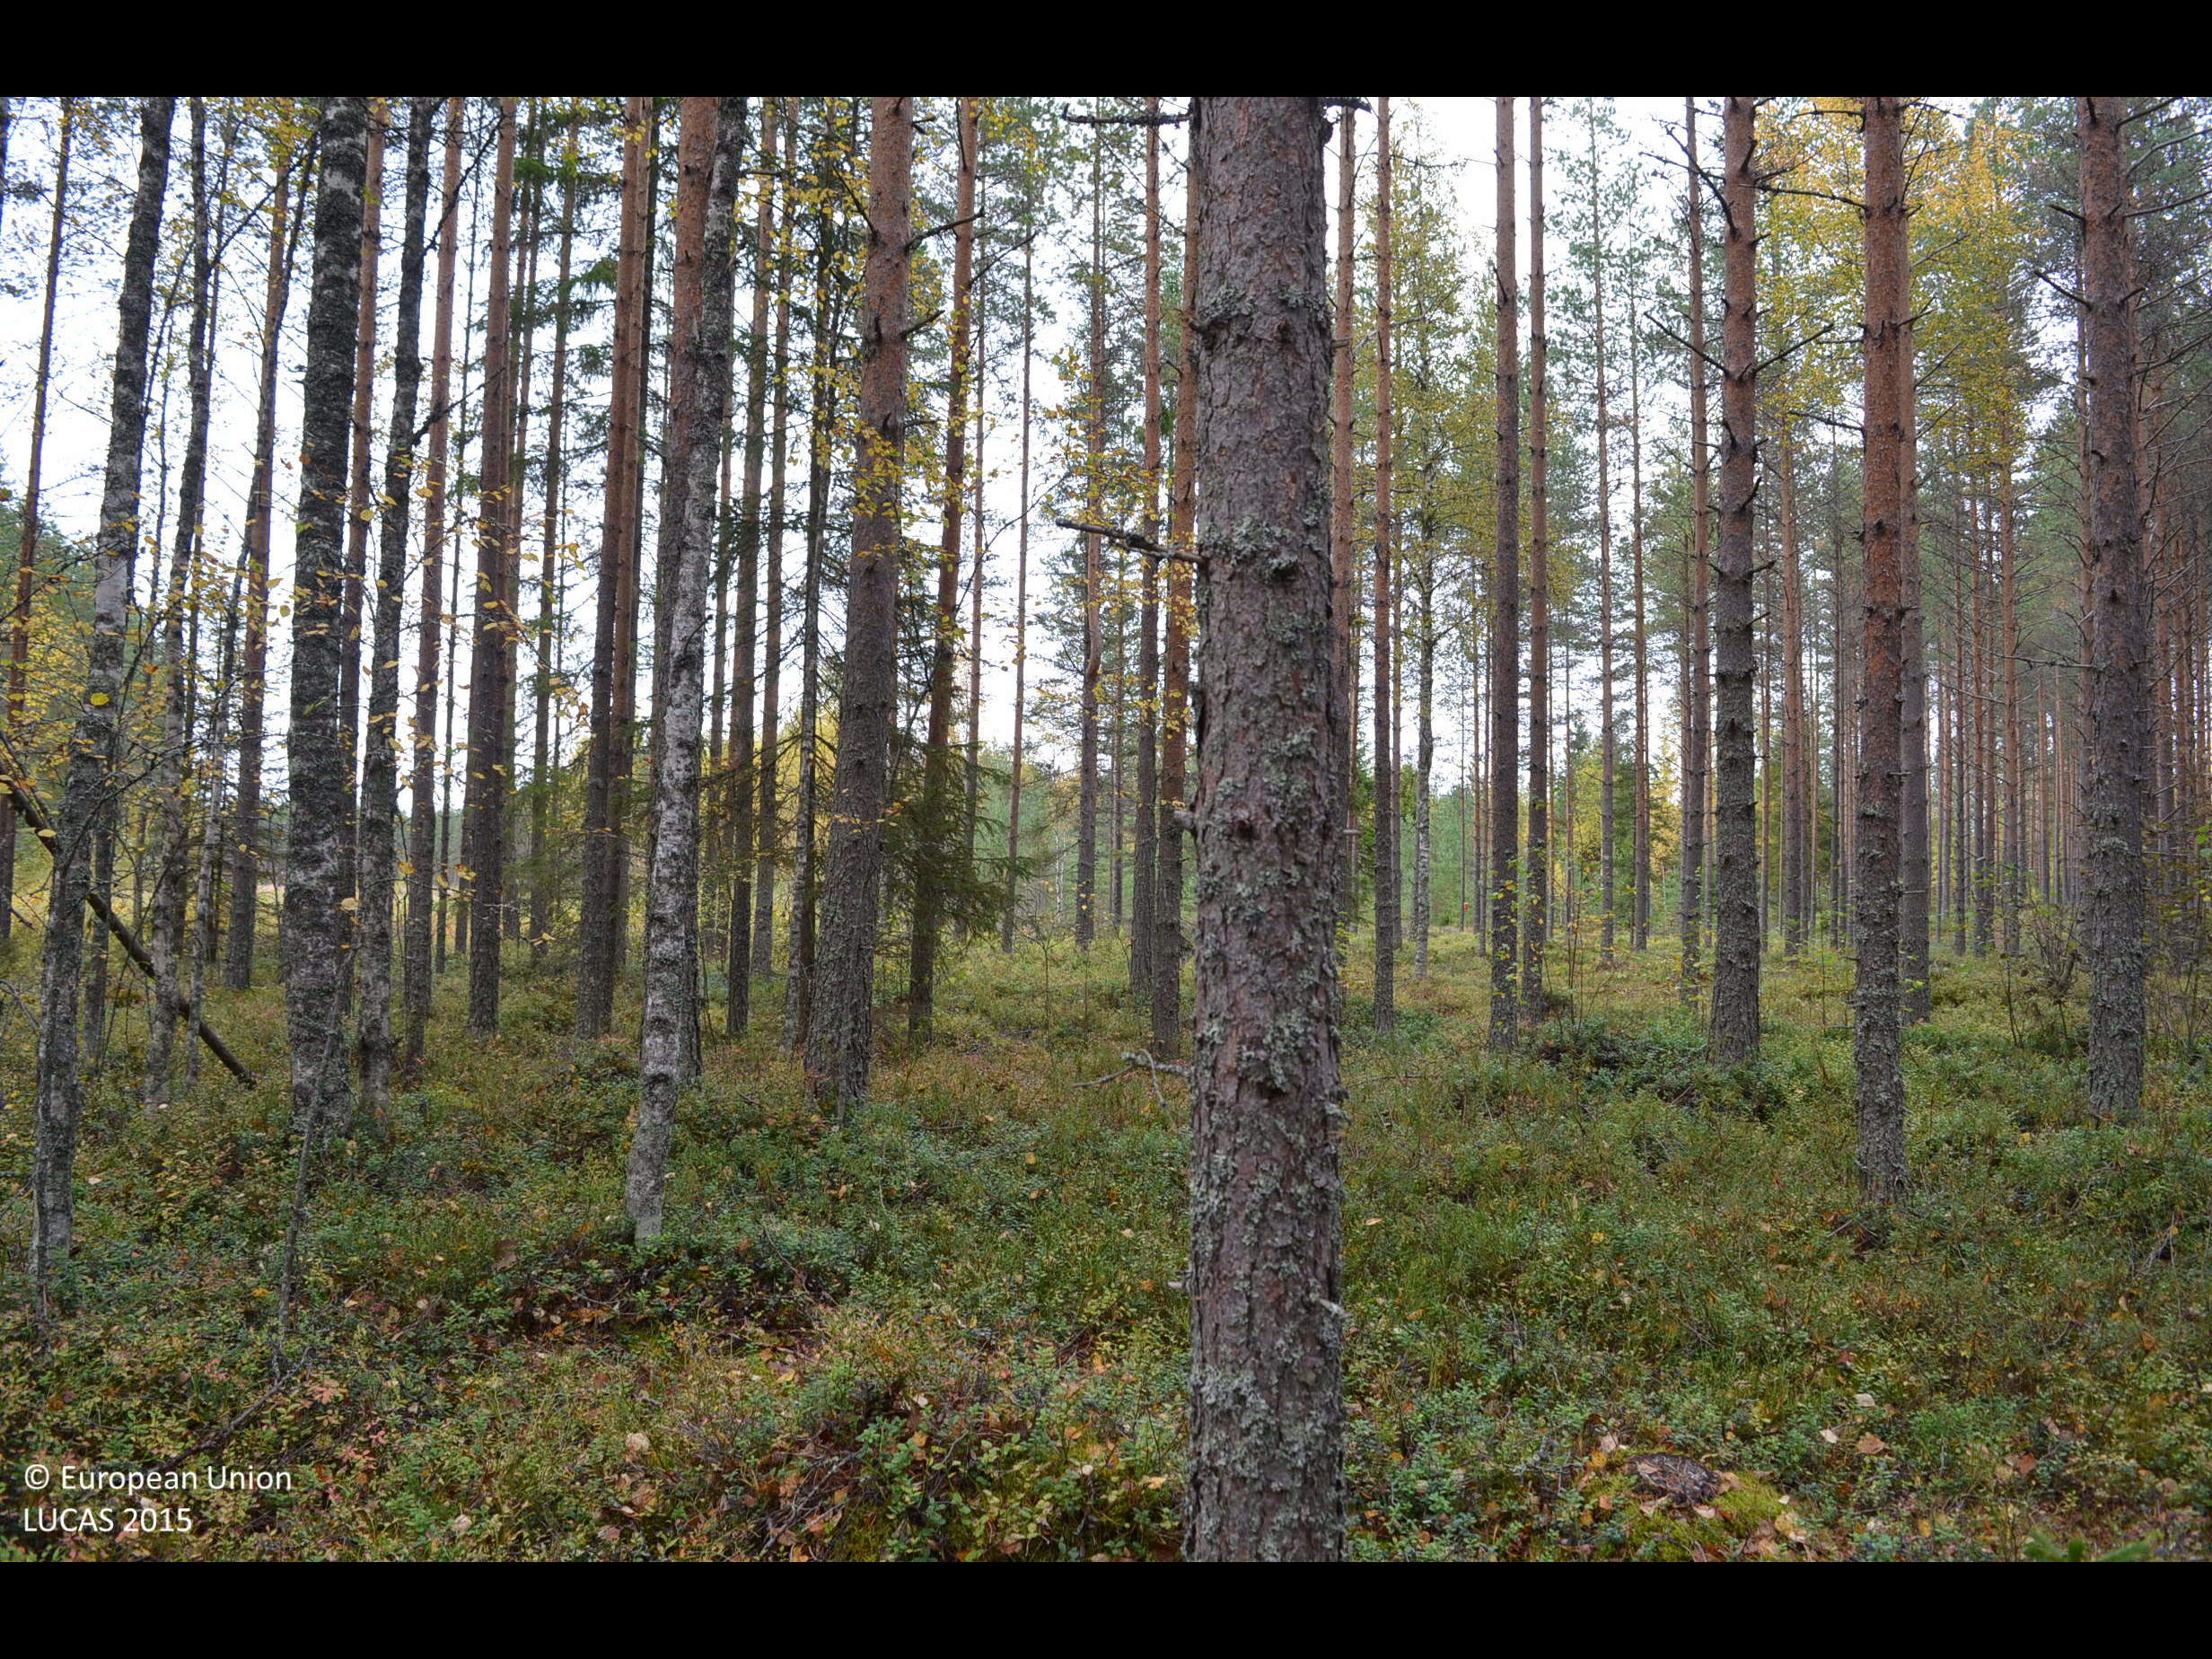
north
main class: Woodland
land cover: Pine dominated mixed woodland
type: boreal forest
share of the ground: > 75 %
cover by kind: coniferous forest trees 55 %, shrubs 25 %, broadleaved forest trees 20 %
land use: Forestry
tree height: > 5 m
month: September
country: FI
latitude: 62.7550
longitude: 23.8792
